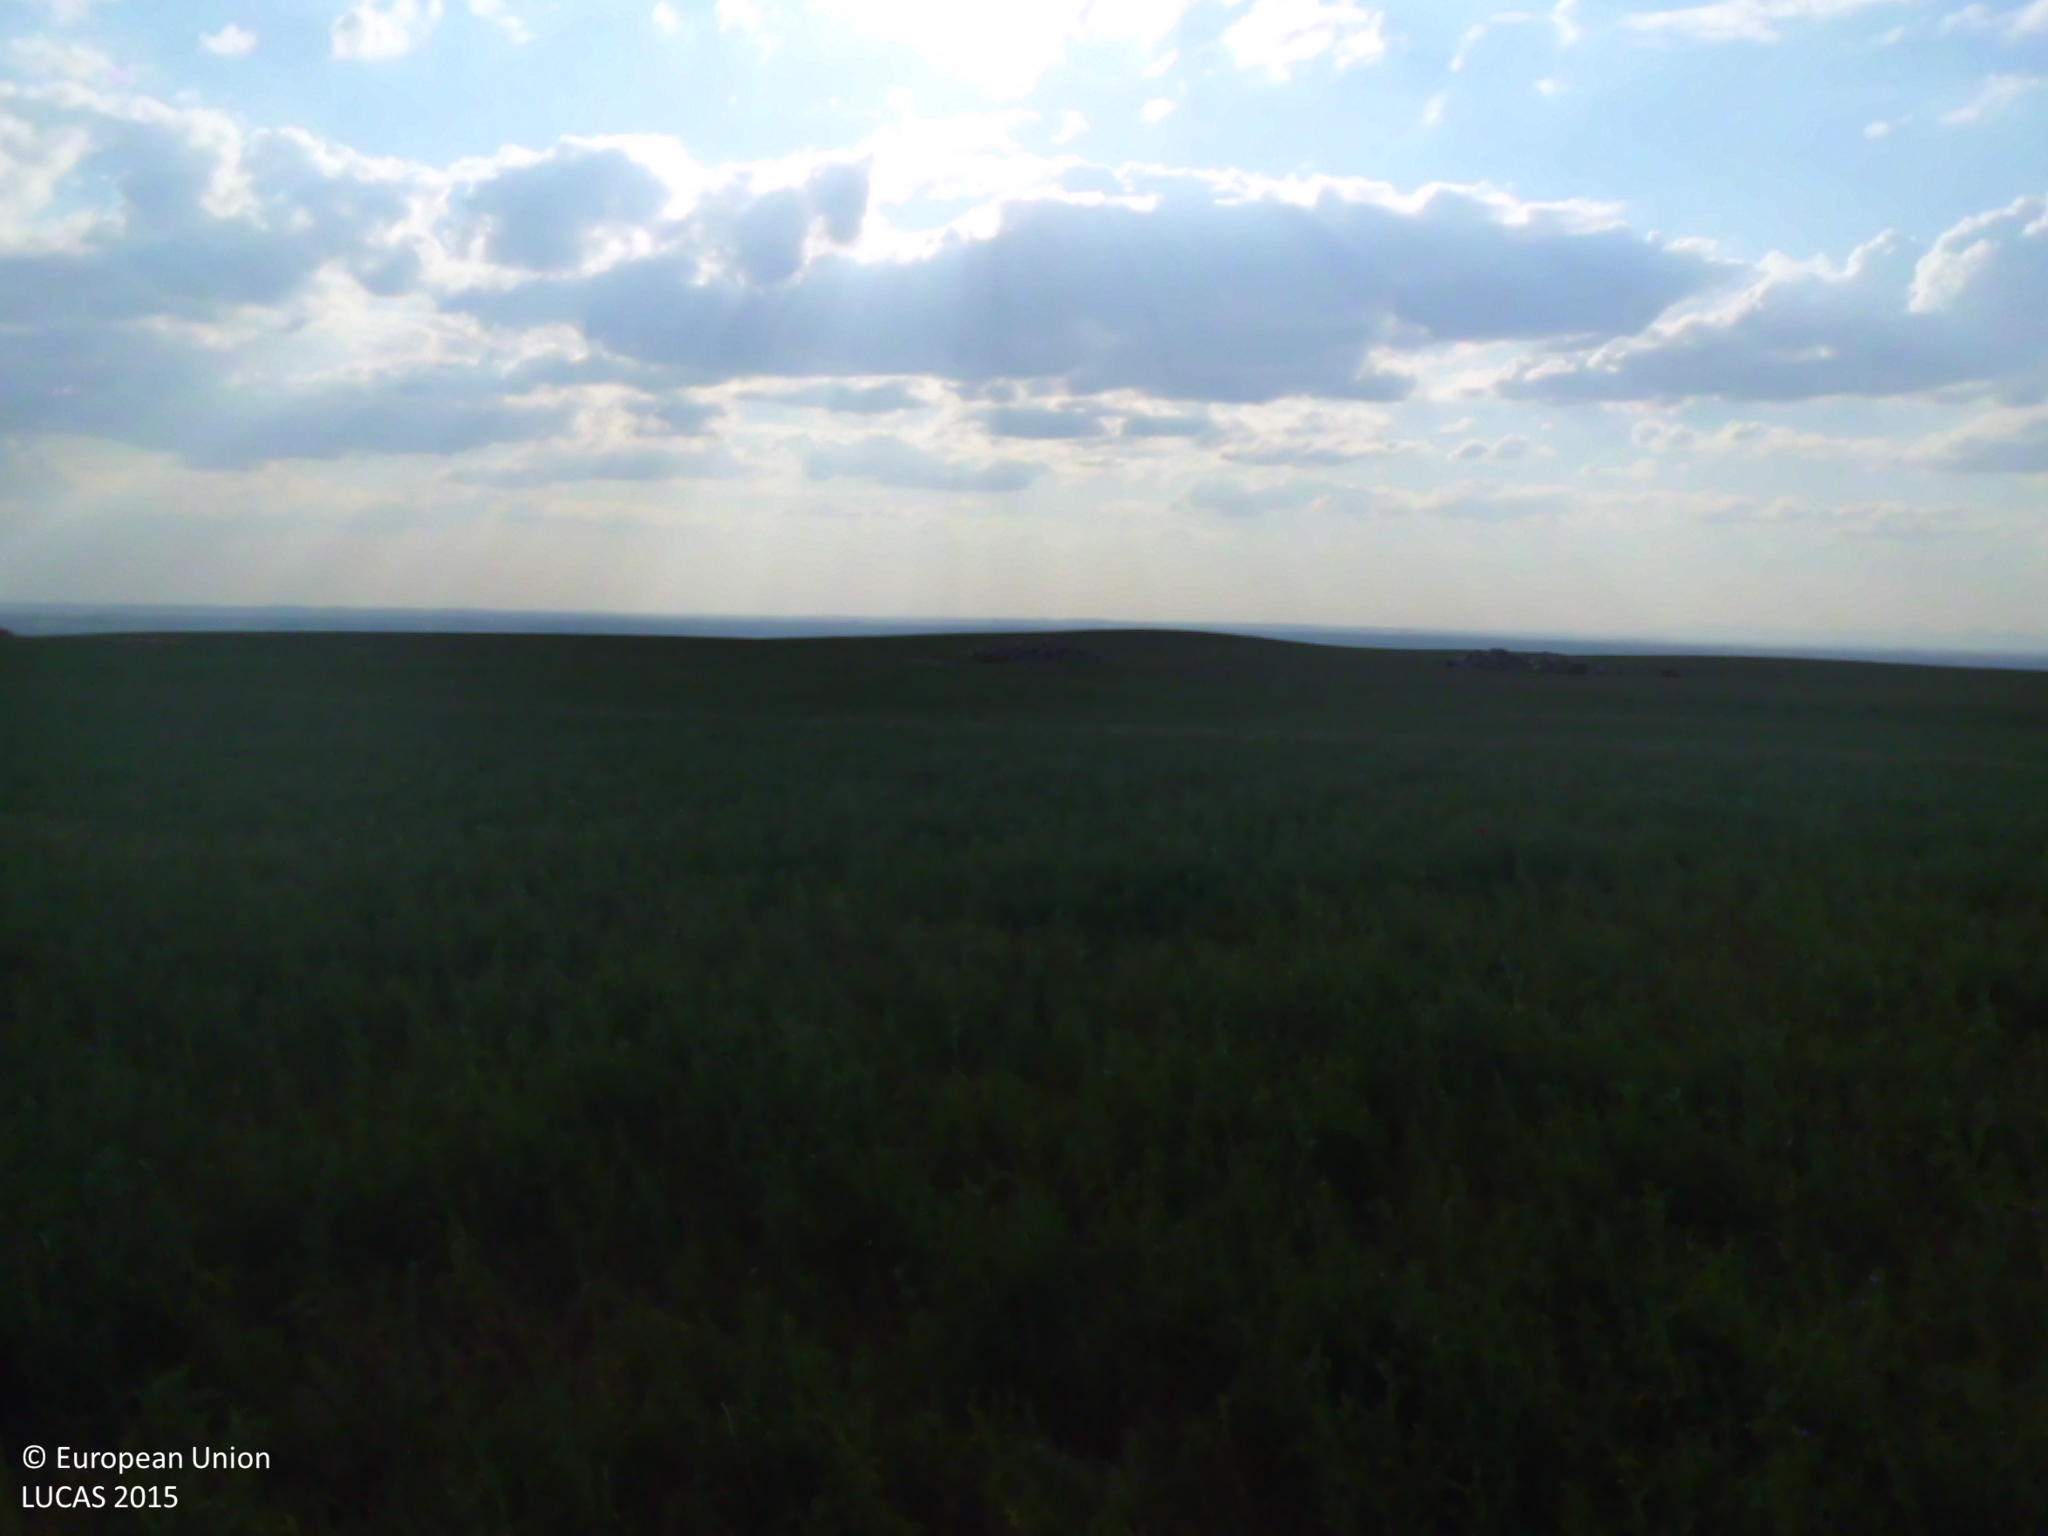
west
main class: Cropland
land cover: Dry pulses
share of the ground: > 75 %
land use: Agriculture (excluding fallow land and kitchen gardens)
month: June
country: ES
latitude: 42.4256
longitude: -4.0070
